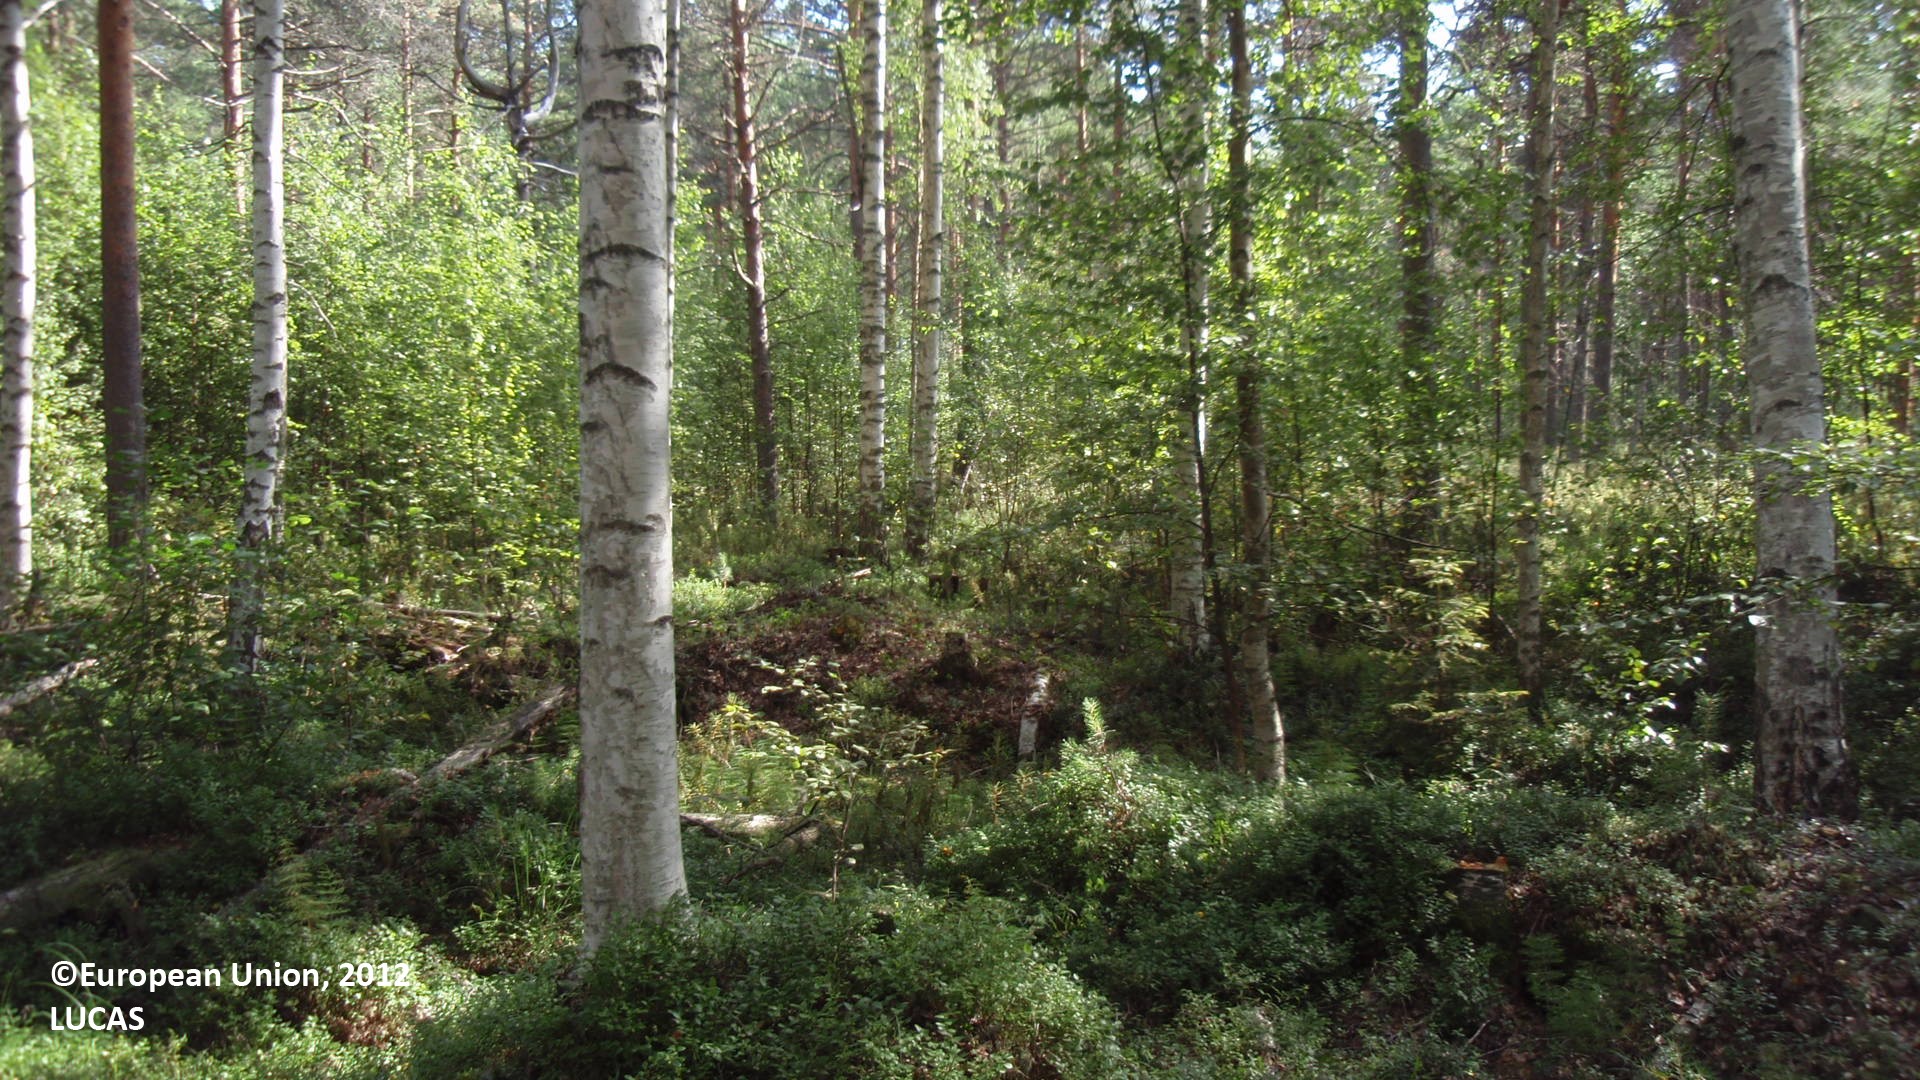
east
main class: Woodland
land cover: Pine dominated mixed woodland
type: boreal forest
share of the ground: 50 - 75 %
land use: Forestry
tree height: > 5 m
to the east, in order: Pine dominated mixed woodland; Ditches and canals; Pine dominated mixed woodland; Ditches and canals; Pine dominated mixed woodland; Ditches and canals; Pine dominated mixed woodland; Ditches and canals; Pine dominated mixed woodland; Broadleaved woodland; Ditches and canals; Broadleaved woodland; Pine dominated coniferous woodland
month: August
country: FI
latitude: 61.1951
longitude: 28.1565
